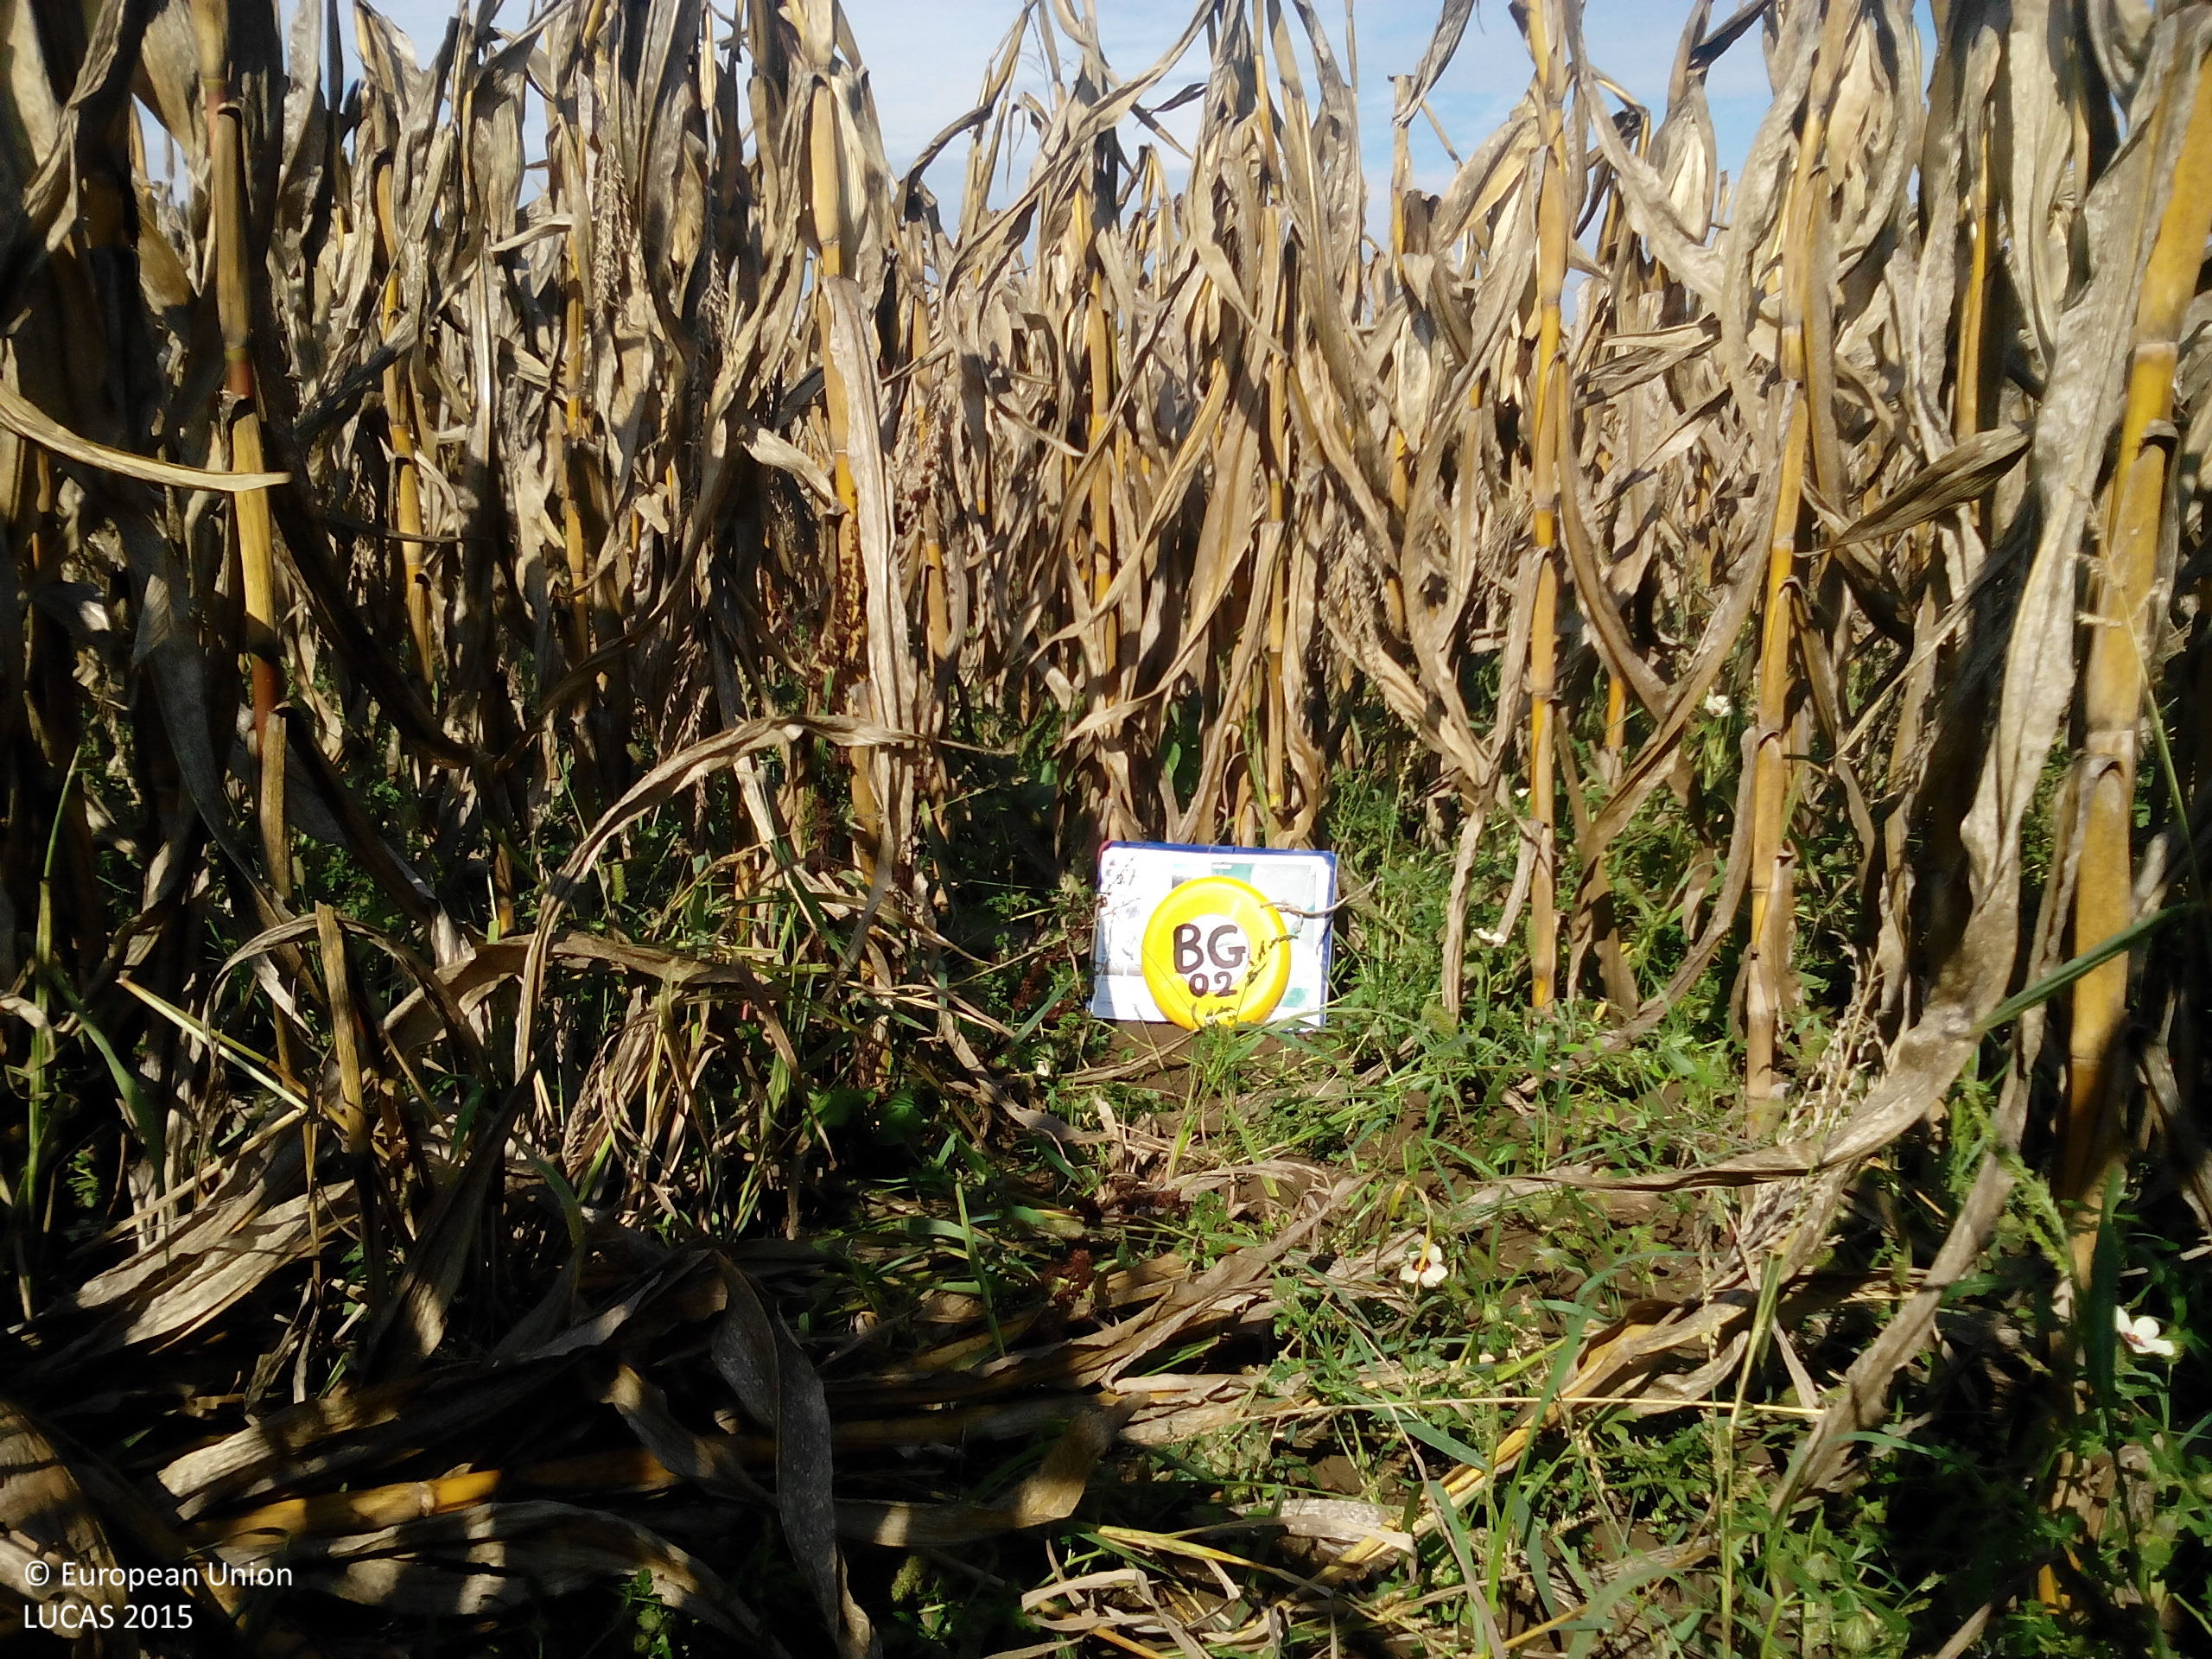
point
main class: Cropland
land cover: Maize
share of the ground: > 75 %
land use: Agriculture (excluding fallow land and kitchen gardens)
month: October
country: BG
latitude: 43.2679
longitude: 23.7341
